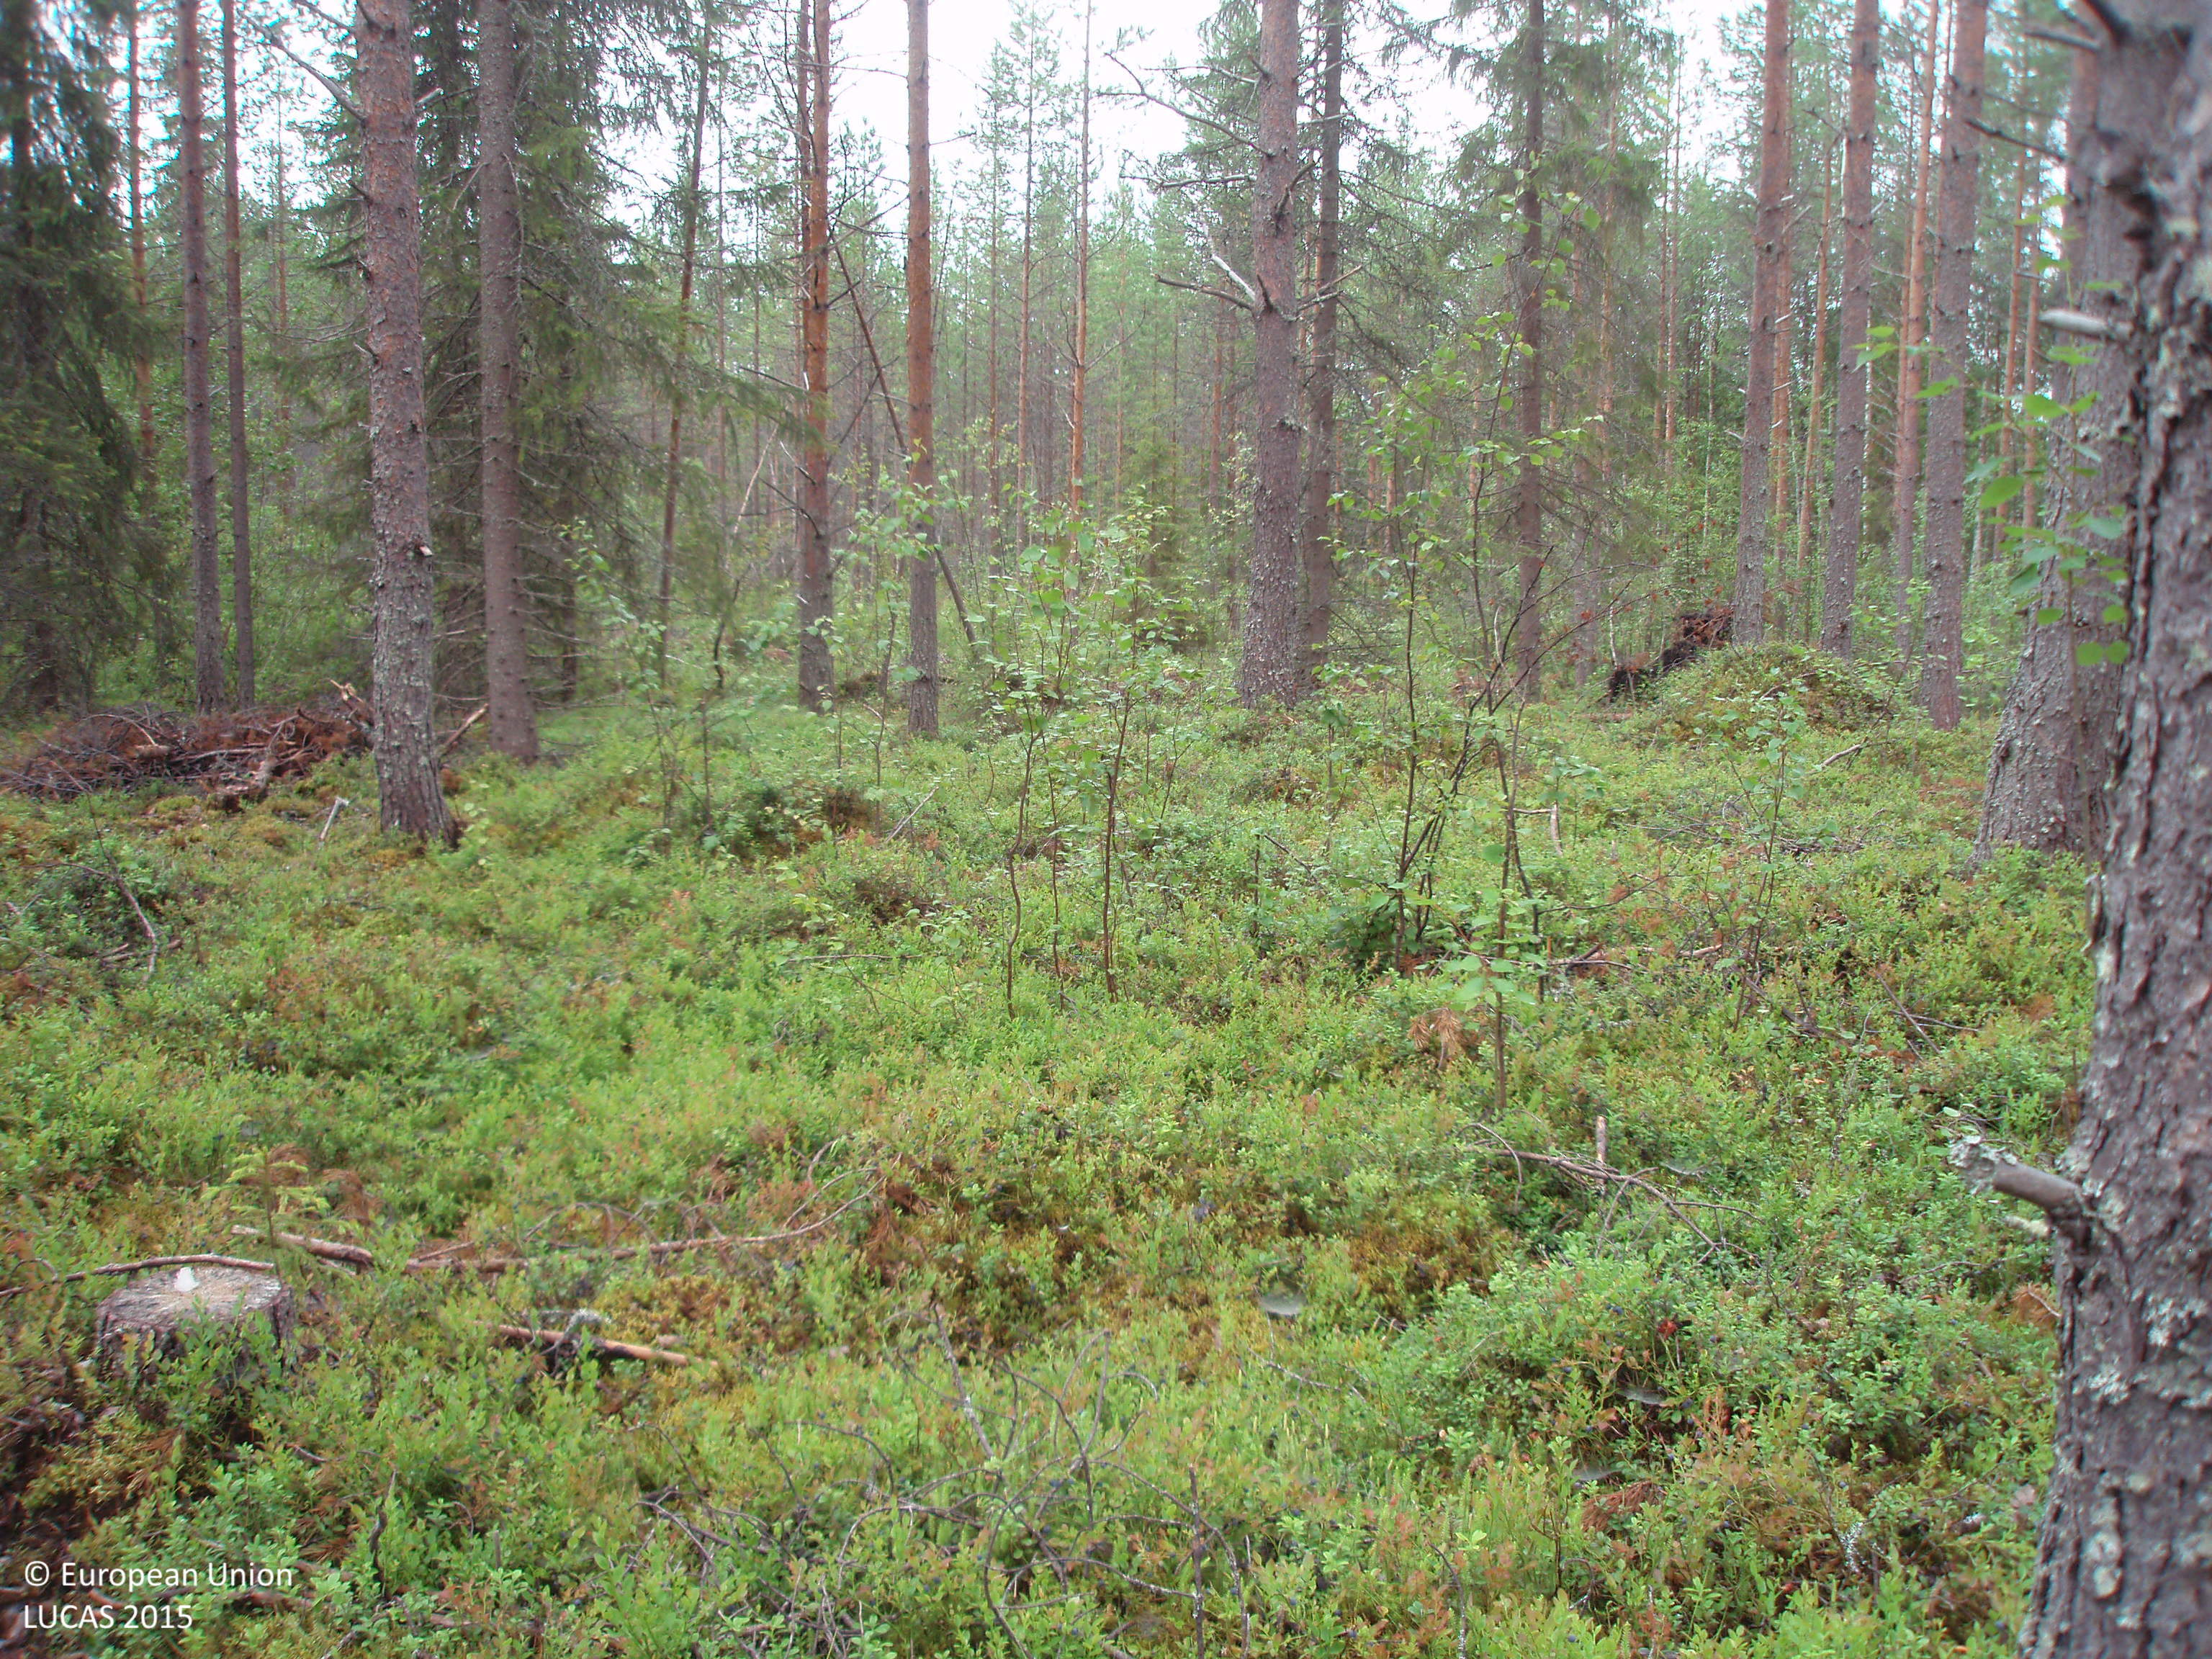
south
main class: Woodland
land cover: Pine dominated coniferous woodland
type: boreal forest
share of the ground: 50 - 75 %
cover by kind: coniferous forest trees 60 %, shrubs 40 %
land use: Forestry
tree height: > 5 m
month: August
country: FI
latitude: 65.5451
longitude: 27.2451
